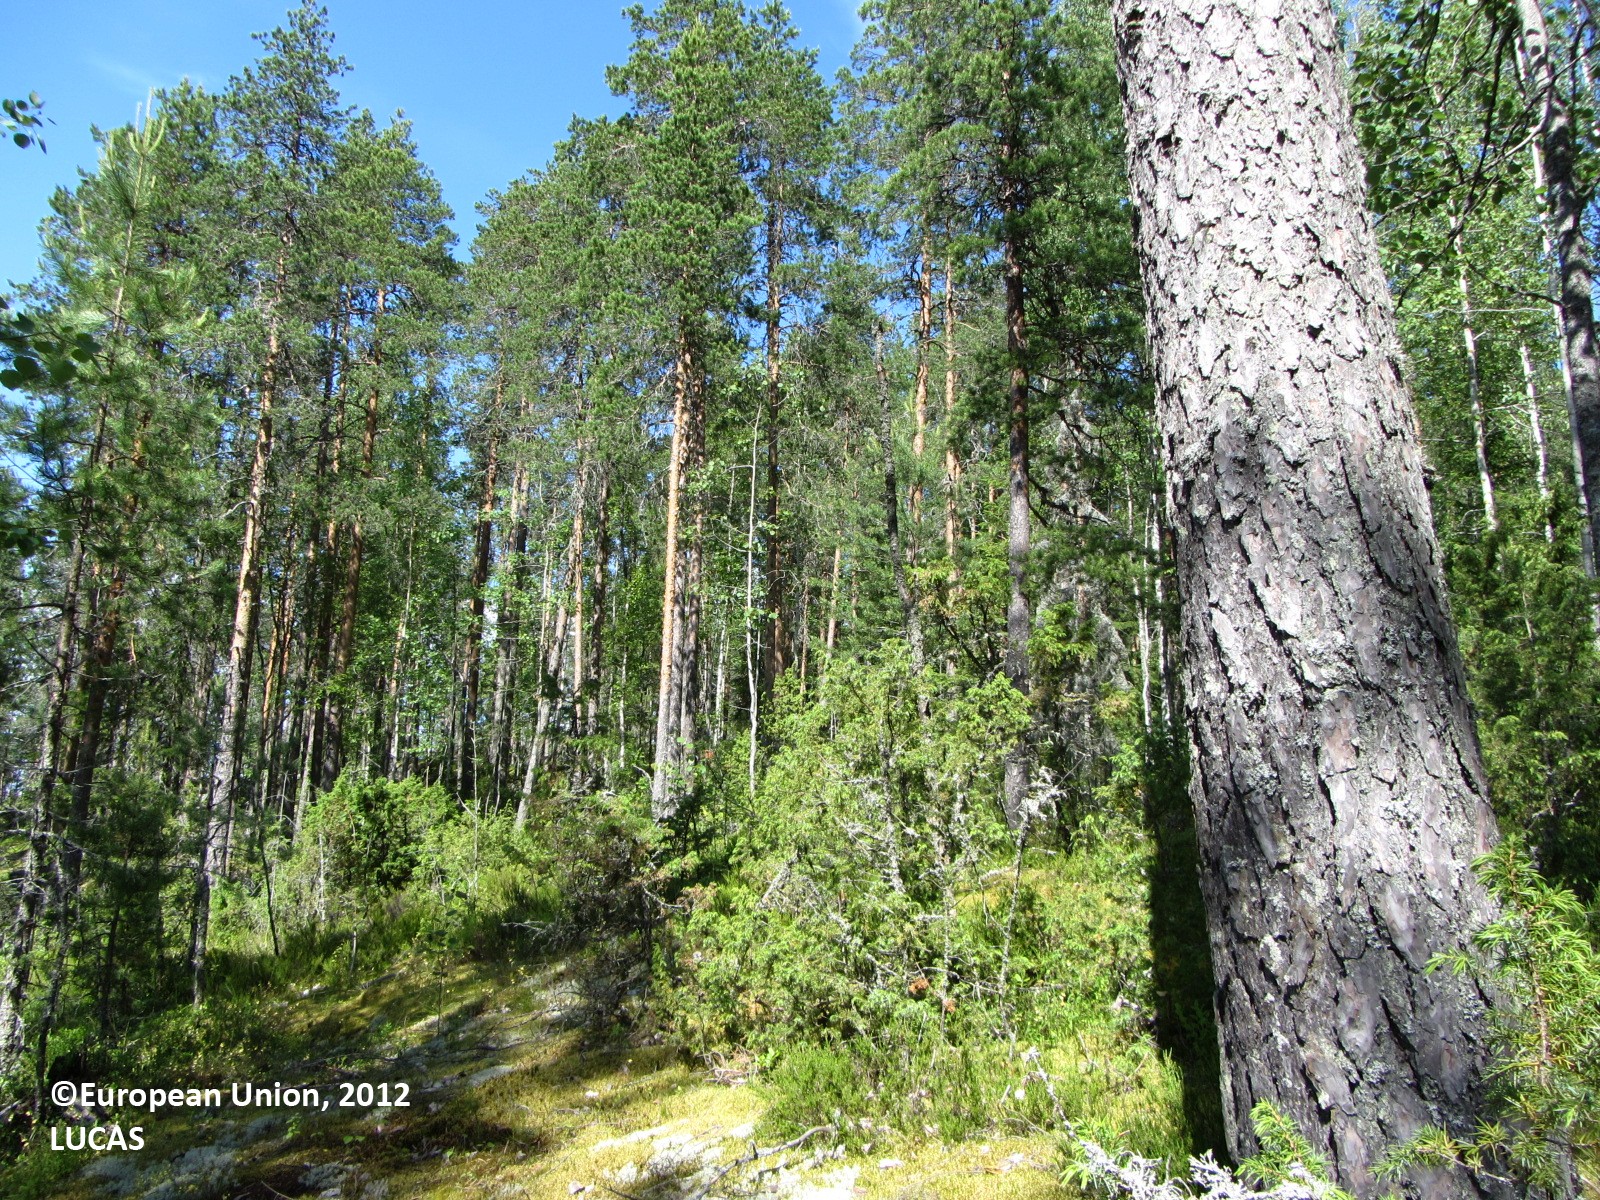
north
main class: Woodland
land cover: Pine dominated coniferous woodland
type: boreal forest
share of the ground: > 75 %
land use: Forestry
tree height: > 5 m
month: July
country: FI
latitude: 63.0650
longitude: 25.6022
